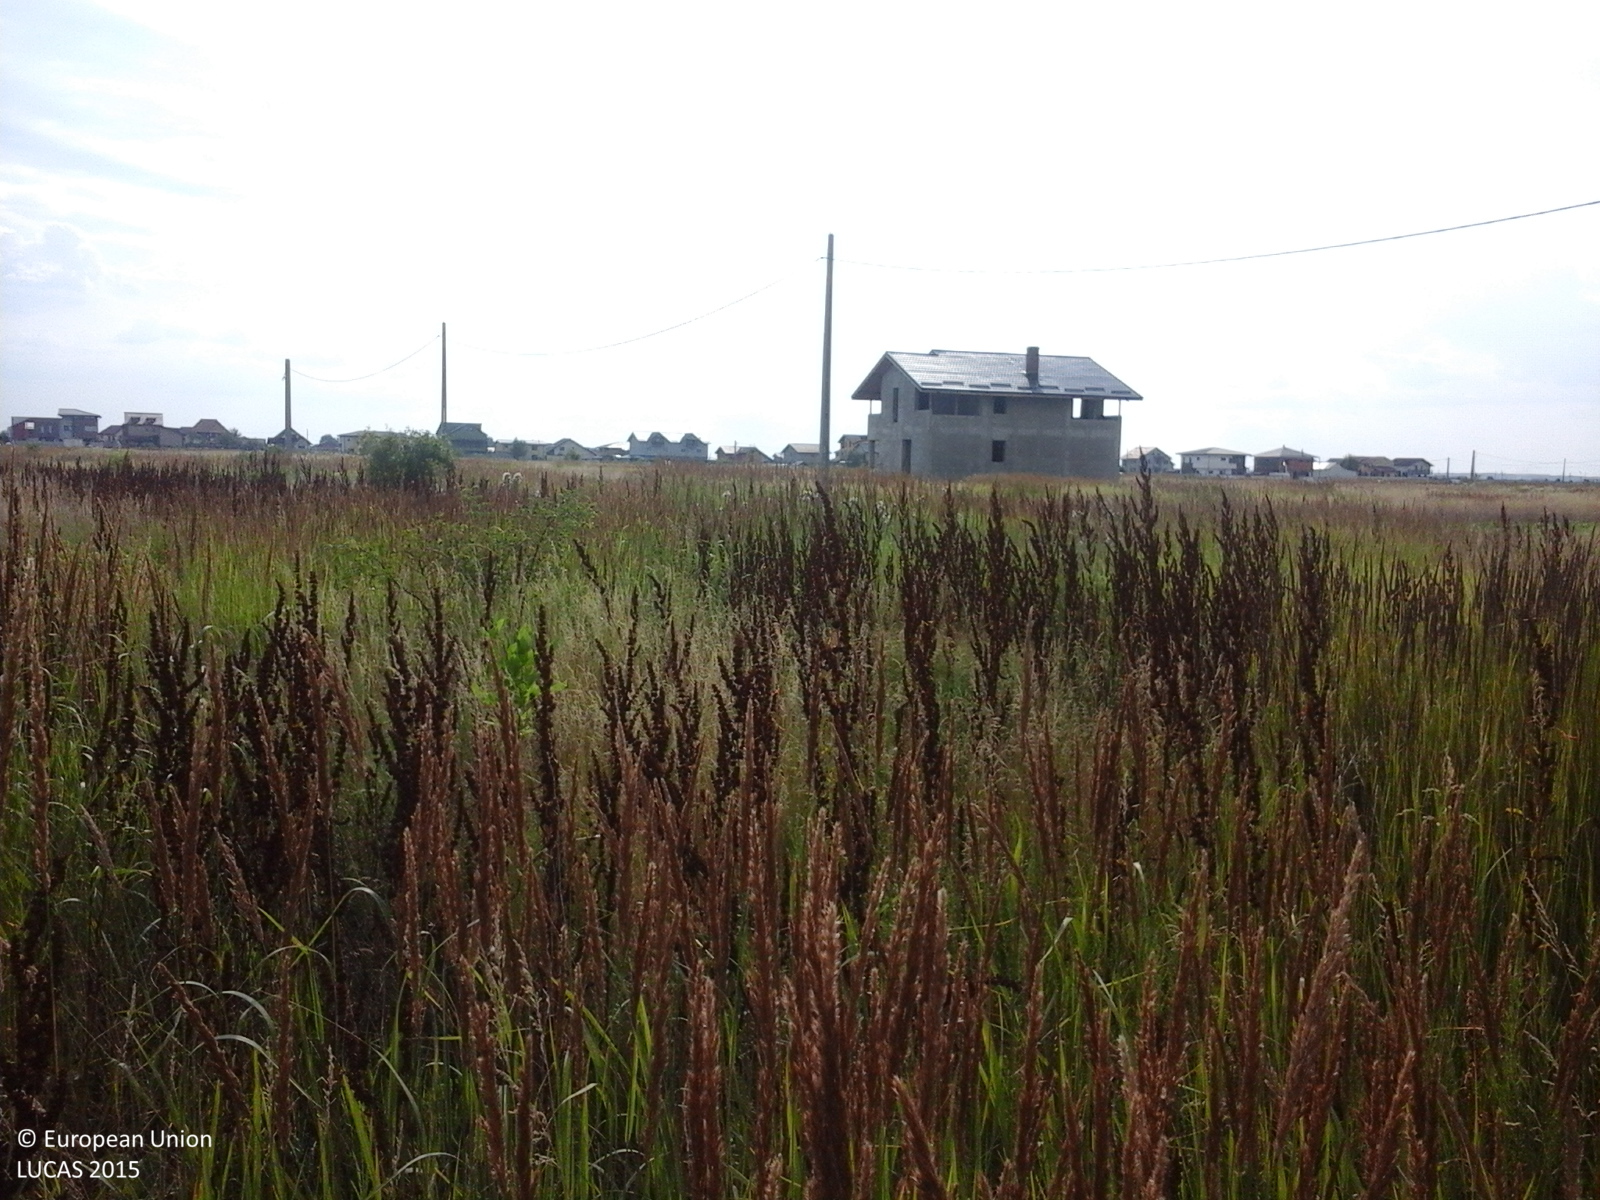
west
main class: Grassland
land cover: Spontaneously vegetated surfaces
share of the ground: > 75 %
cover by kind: herbaceous plants 100 %
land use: Semi-natural and natural areas not in use
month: June
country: RO
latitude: 44.4126
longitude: 25.9369
